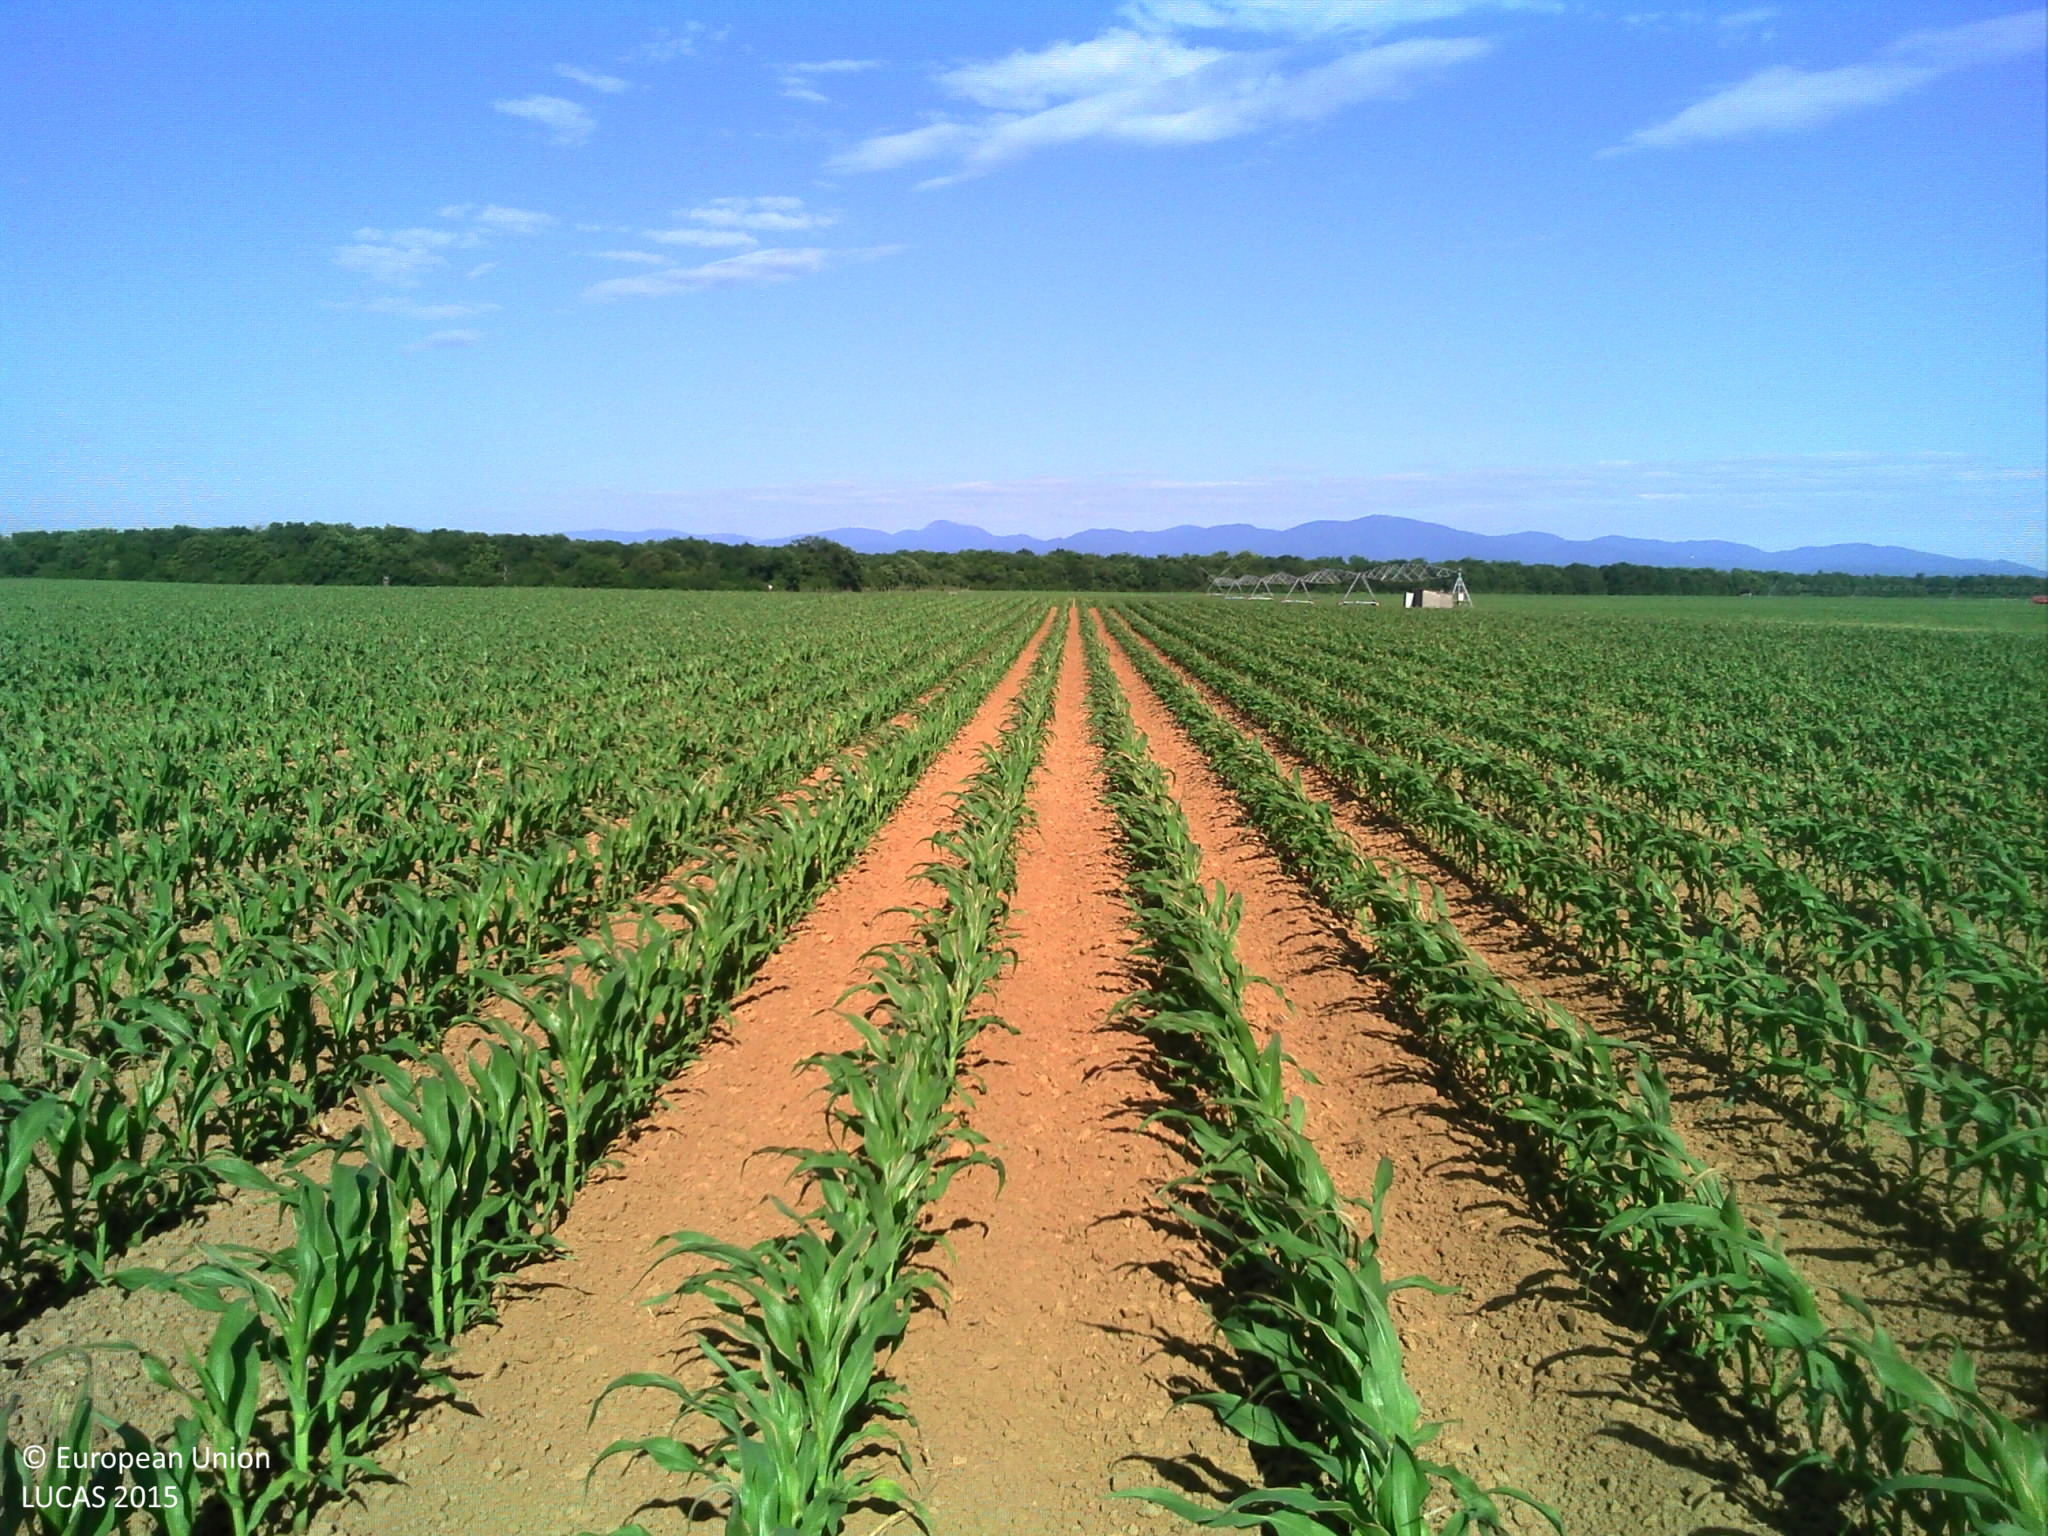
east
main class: Cropland
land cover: Maize
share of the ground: 50 - 75 %
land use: Agriculture (excluding fallow land and kitchen gardens)
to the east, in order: Maize
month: June
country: FR
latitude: 47.8327
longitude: 7.3963
